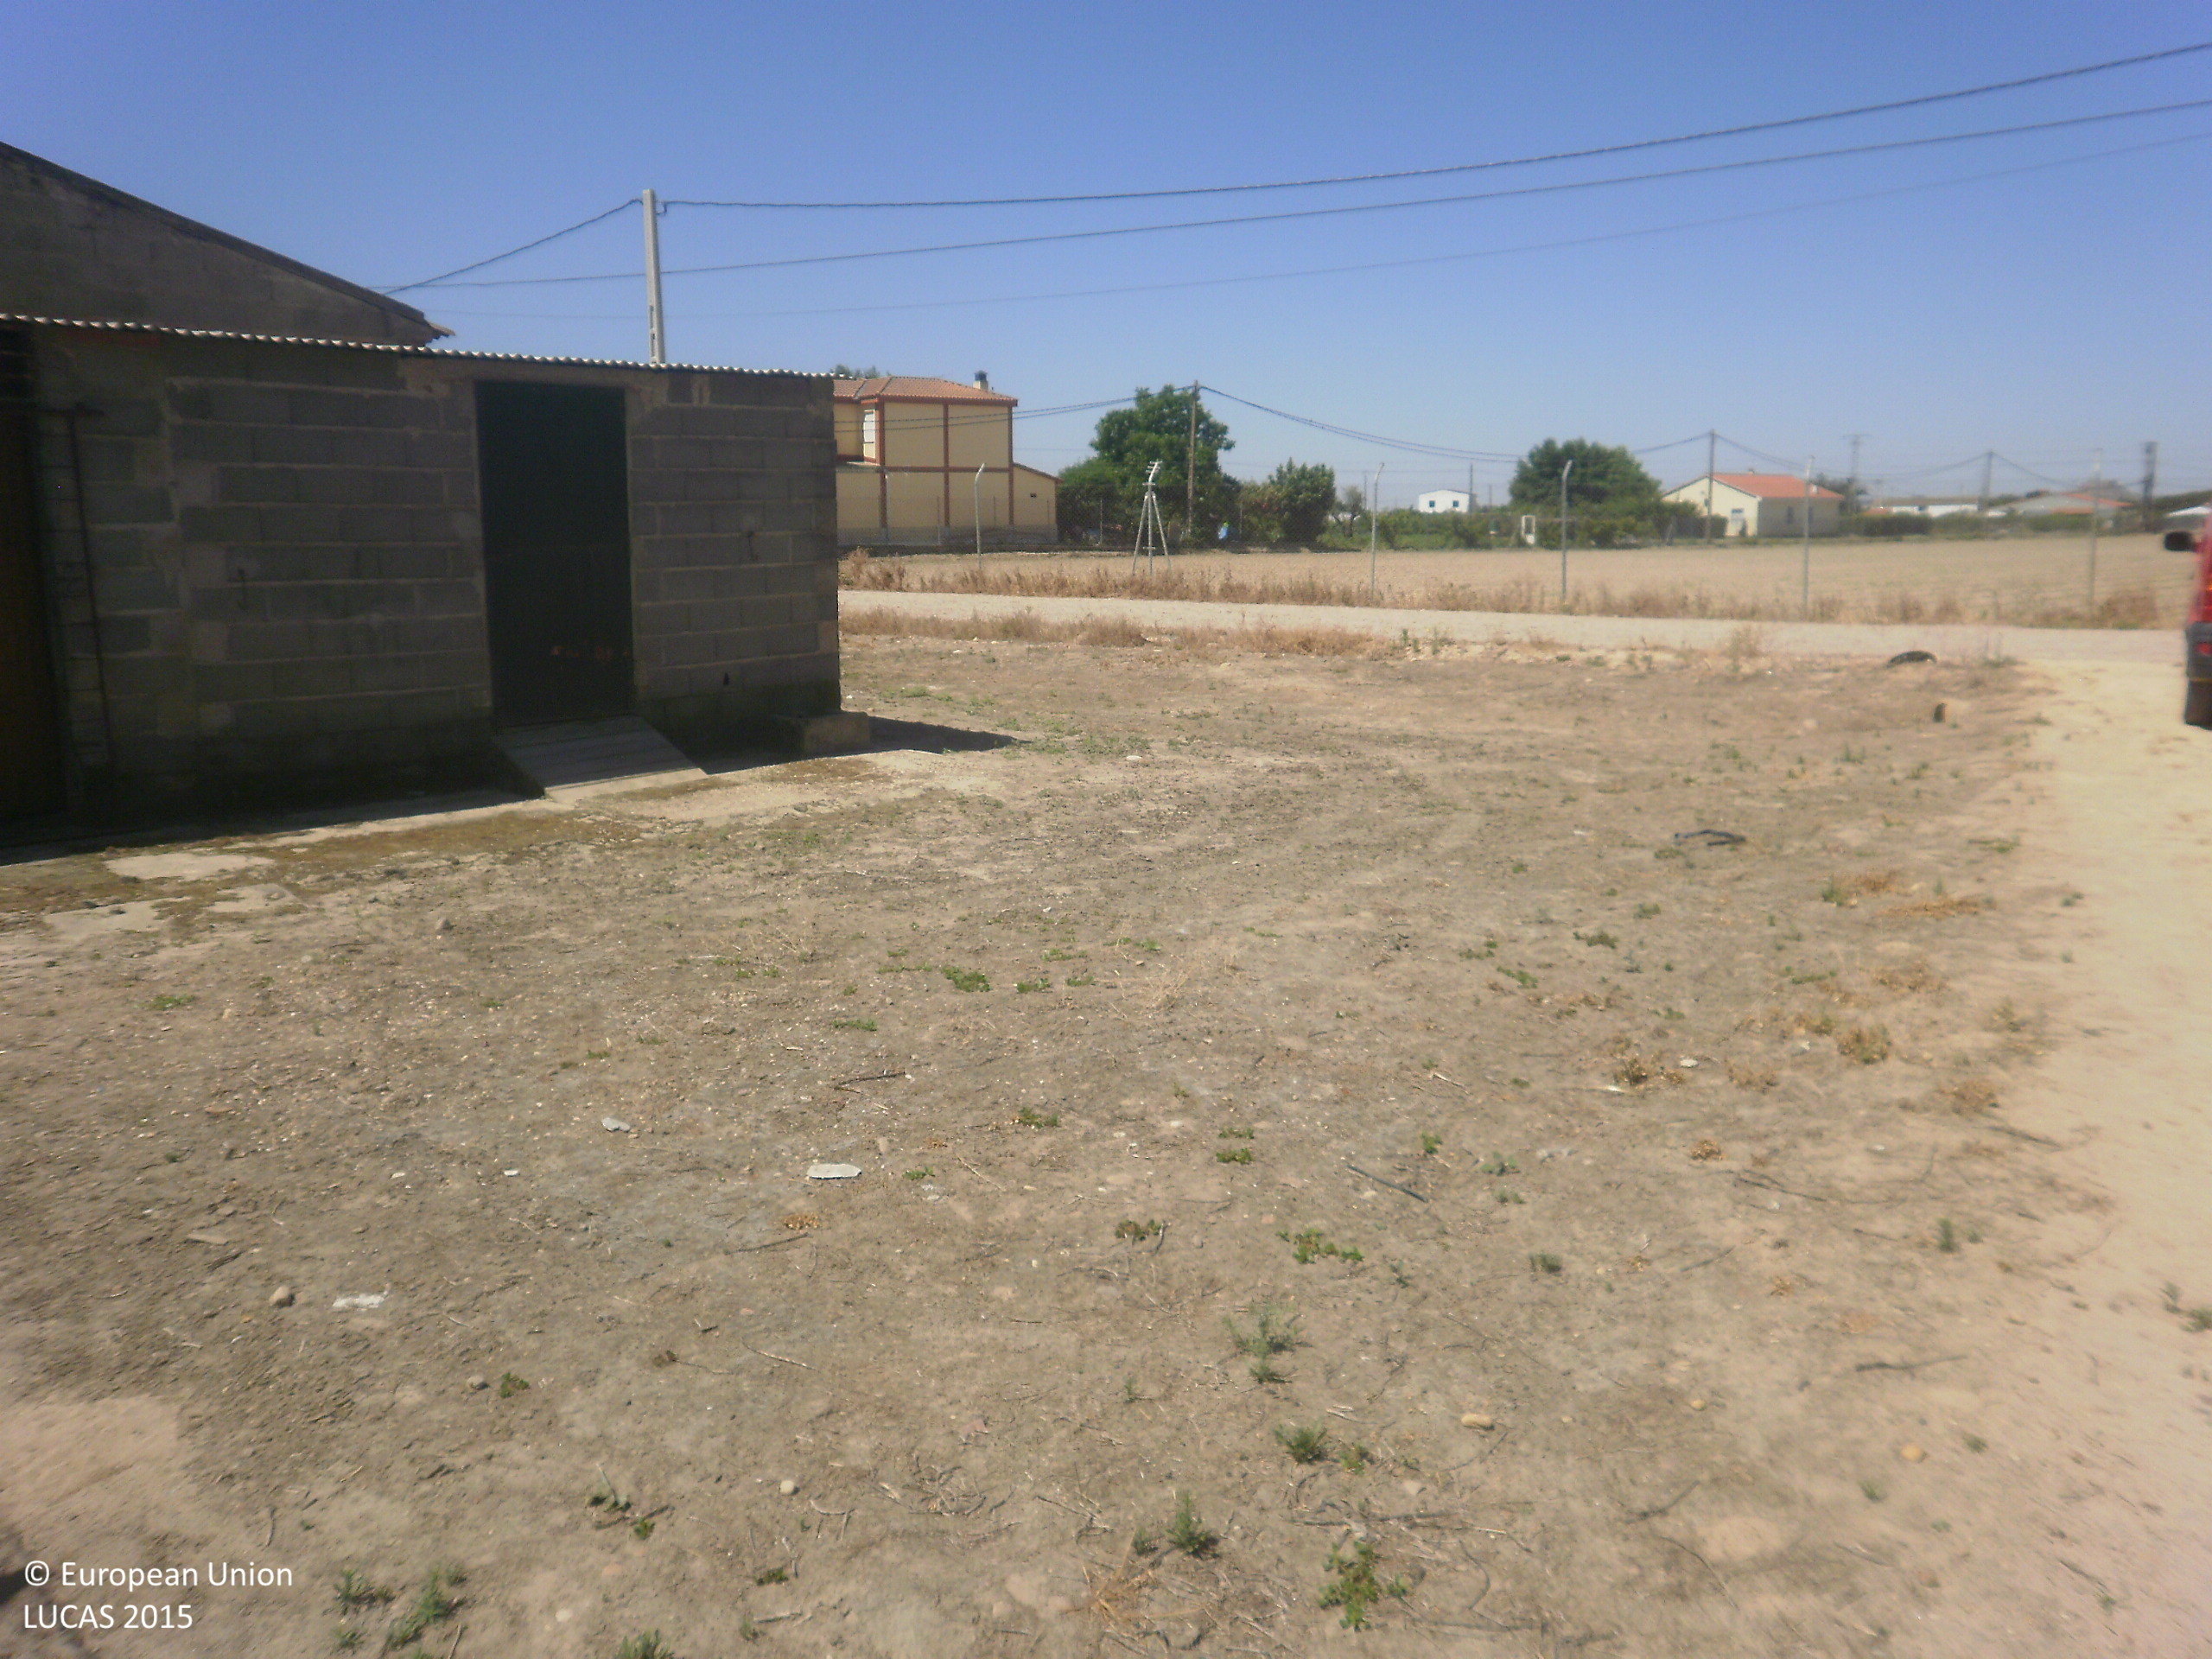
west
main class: Cropland
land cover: Other fruit trees and berries
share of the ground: 25 - 50 %
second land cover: Other bare soil
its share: > 75 %
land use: Agriculture (excluding fallow land and kitchen gardens)
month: May
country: ES
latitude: 38.9621
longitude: -5.8952
